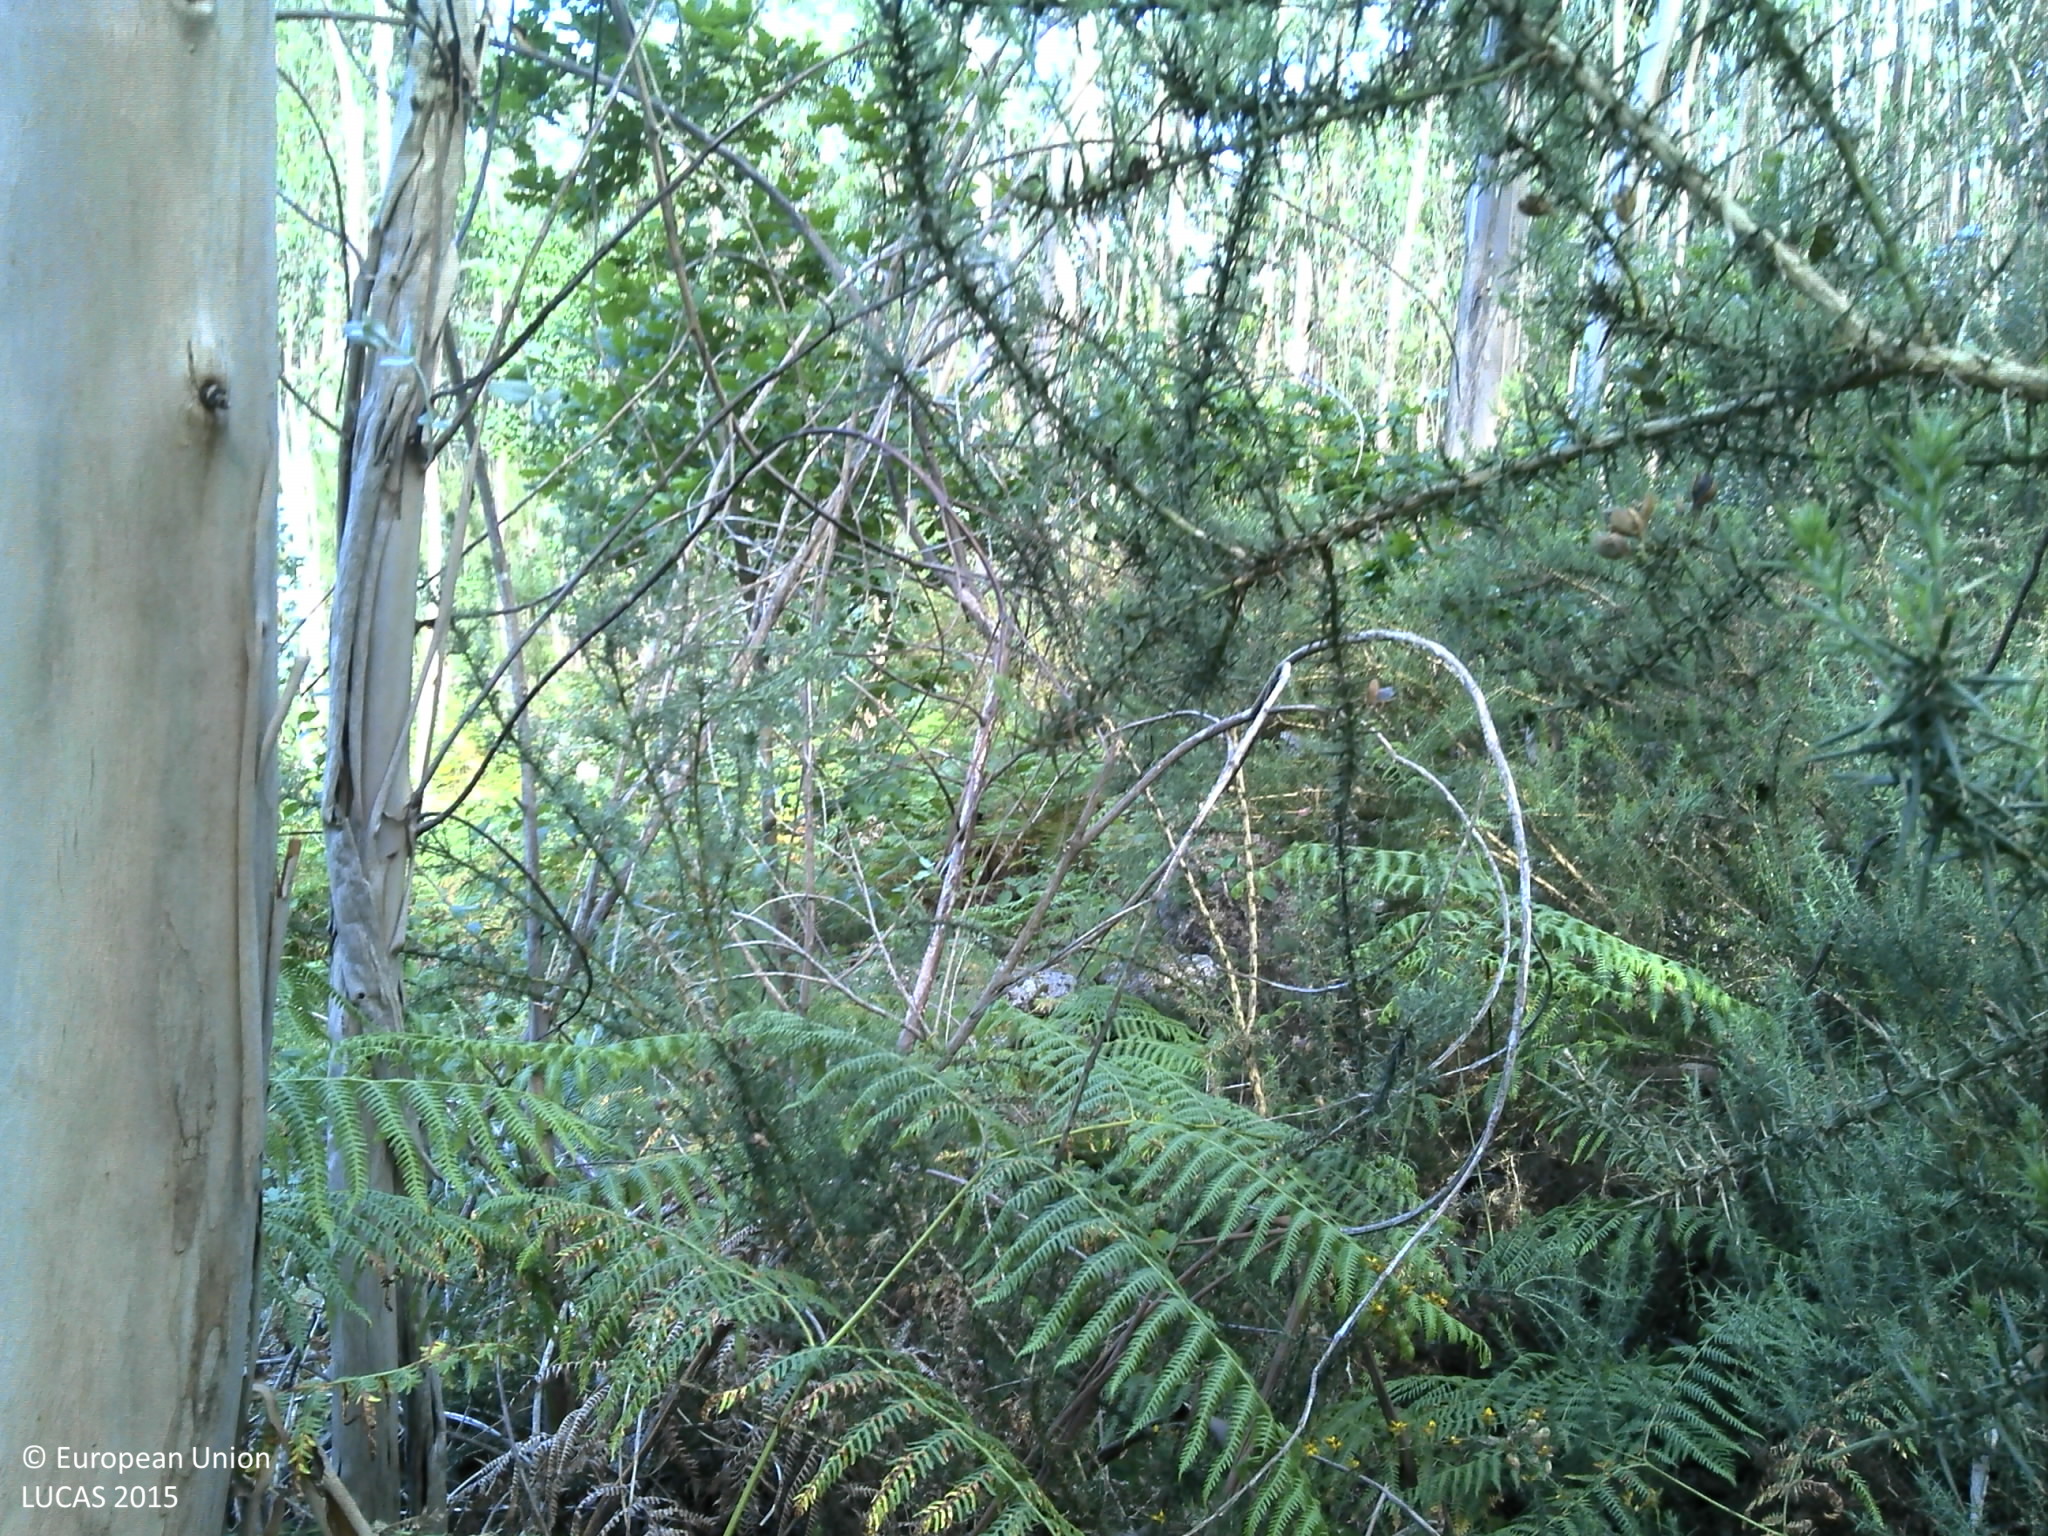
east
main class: Woodland
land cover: Broadleaved woodland
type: exotic forest
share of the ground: 50 - 75 %
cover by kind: broadleaved forest trees 80 %, shrubs 20 %
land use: Forestry
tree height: > 5 m
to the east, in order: Broadleaved woodland; Dry stone walls; Broadleaved woodland; Tracks; Broadleaved woodland; Tracks; Broadleaved woodland
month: May
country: PT
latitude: 41.6840
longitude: -8.7261
